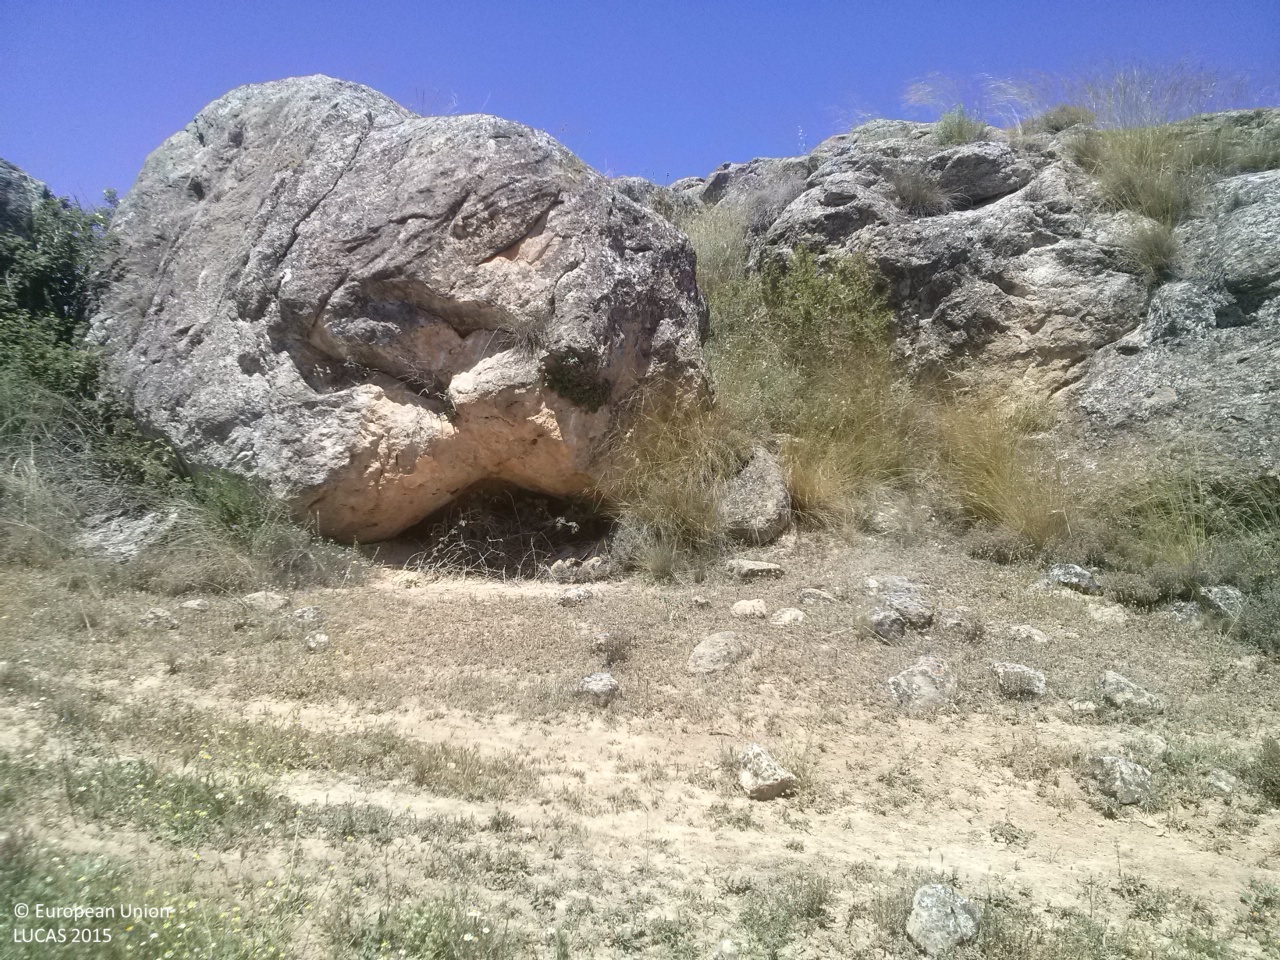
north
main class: Shrubland
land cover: Shrubland without tree cover
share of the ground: 25 - 50 %
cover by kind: shrubs 50 %, herbaceous plants 30 %, unconsolidated bare surface 20 %
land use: Semi-natural and natural areas not in use
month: May
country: ES
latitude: 40.2718
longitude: -2.7604
